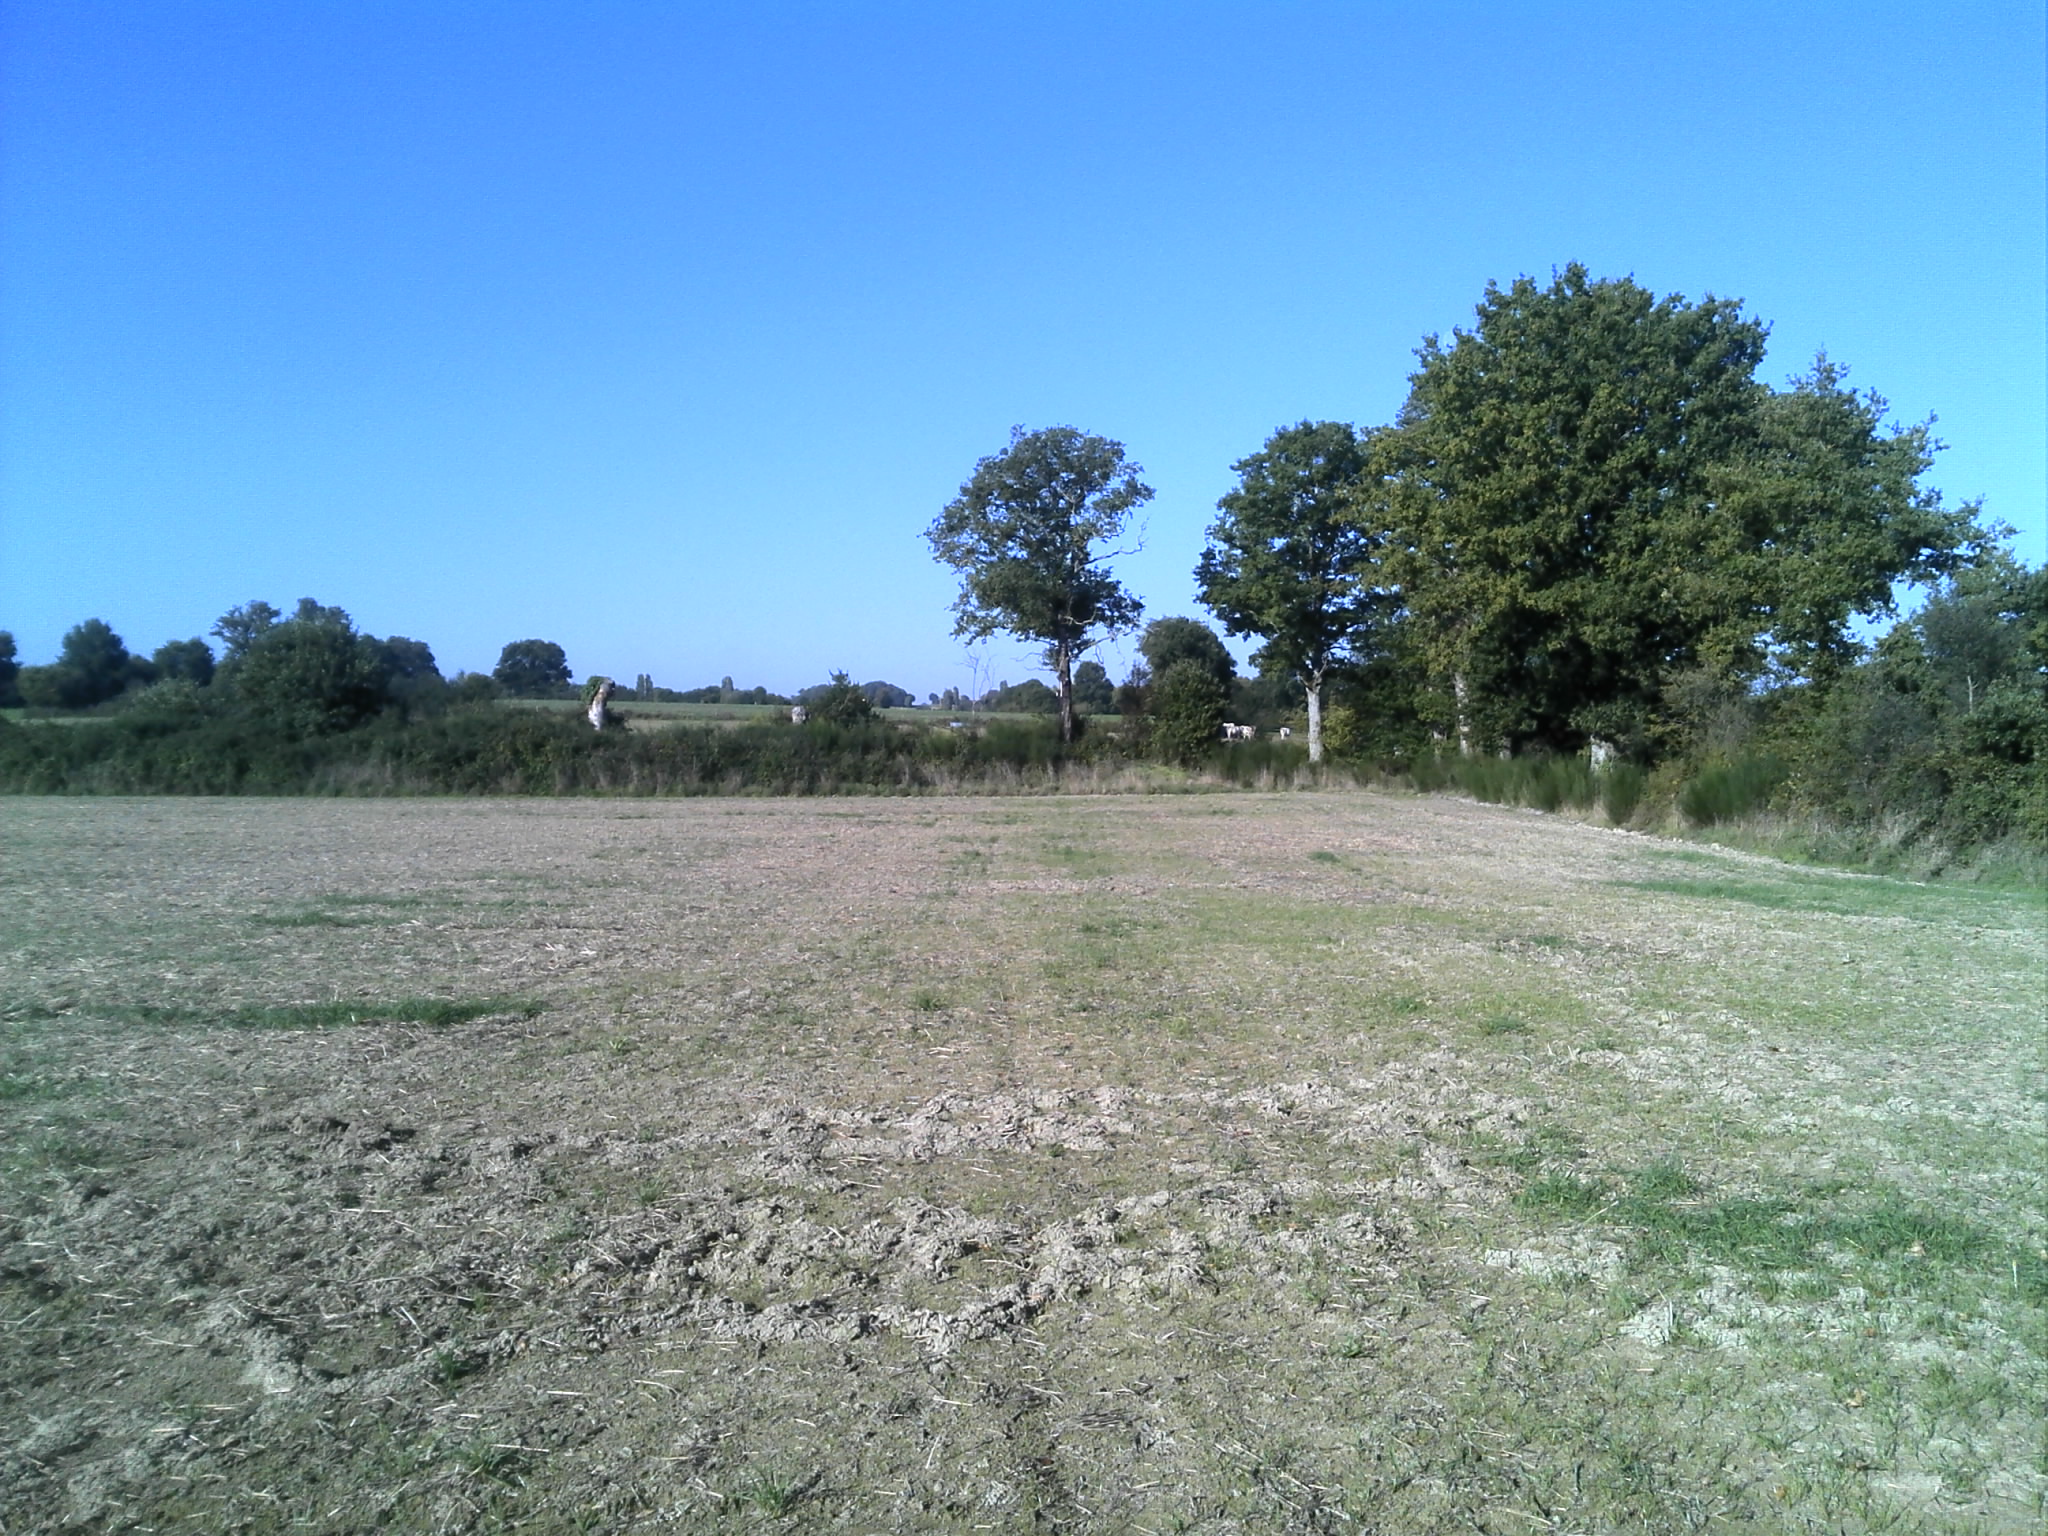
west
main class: Cropland
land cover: Temporary grasslands
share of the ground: > 75 %
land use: Agriculture (excluding fallow land and kitchen gardens)
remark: Harvested field
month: October
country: FR
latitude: 47.6279
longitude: -1.0699
